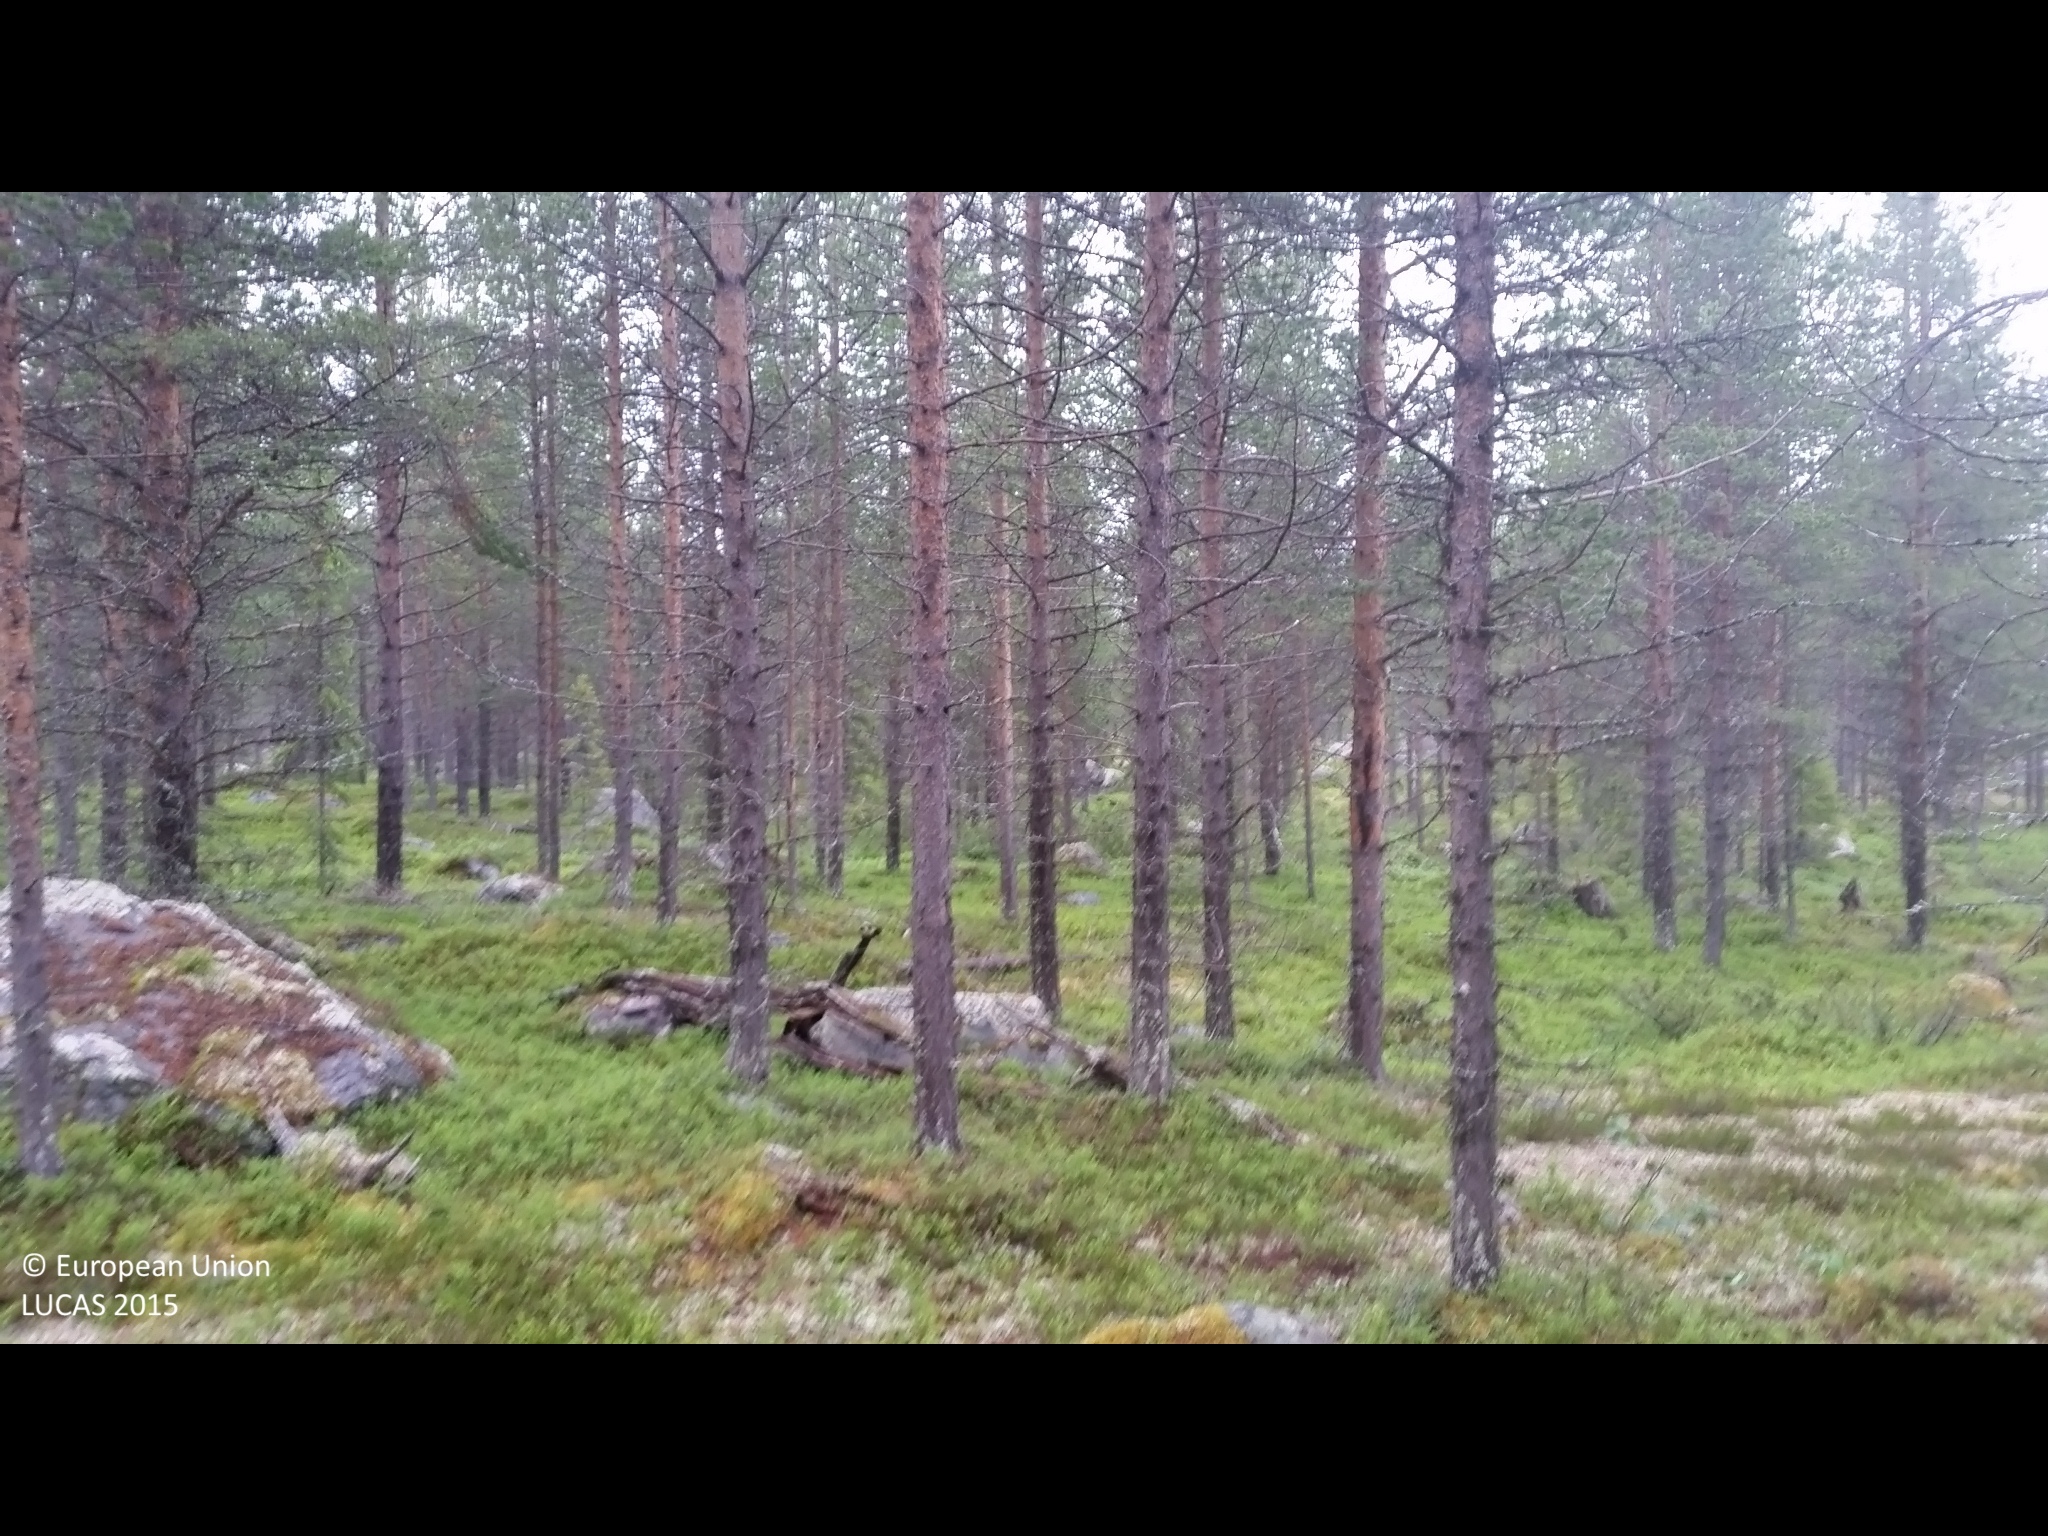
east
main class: Woodland
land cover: Pine dominated coniferous woodland
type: boreal forest
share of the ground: 50 - 75 %
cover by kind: coniferous forest trees 65 %, shrubs 25 %, lichens and mosses 5 %, consolidated bare surface 5 %
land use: Forestry
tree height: > 5 m
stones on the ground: > 50 %
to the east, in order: Pine dominated coniferous woodland
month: July
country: SE
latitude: 65.8823
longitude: 18.0934
